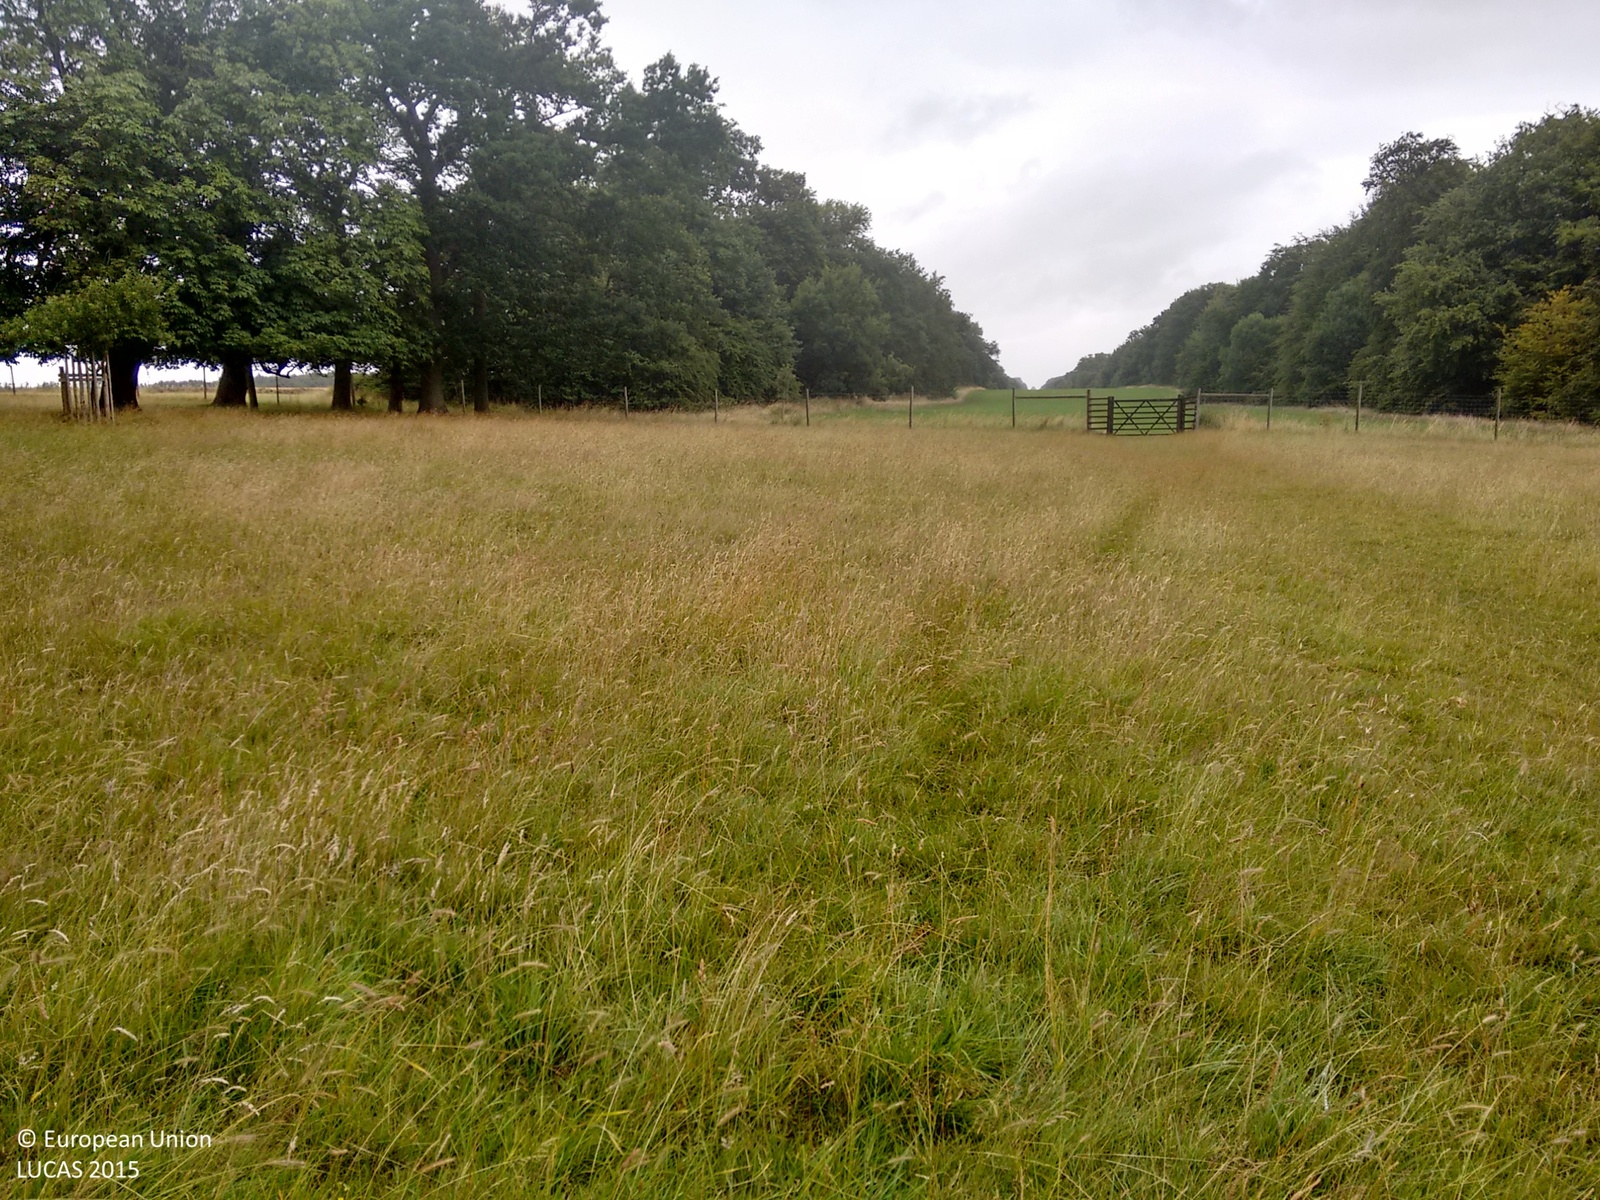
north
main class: Grassland
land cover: Grassland without tree/shrub cover
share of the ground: > 75 %
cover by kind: herbaceous plants 100 %
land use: Amenities, museums, leisure
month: July
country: GB
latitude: 51.5551
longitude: -2.2791
